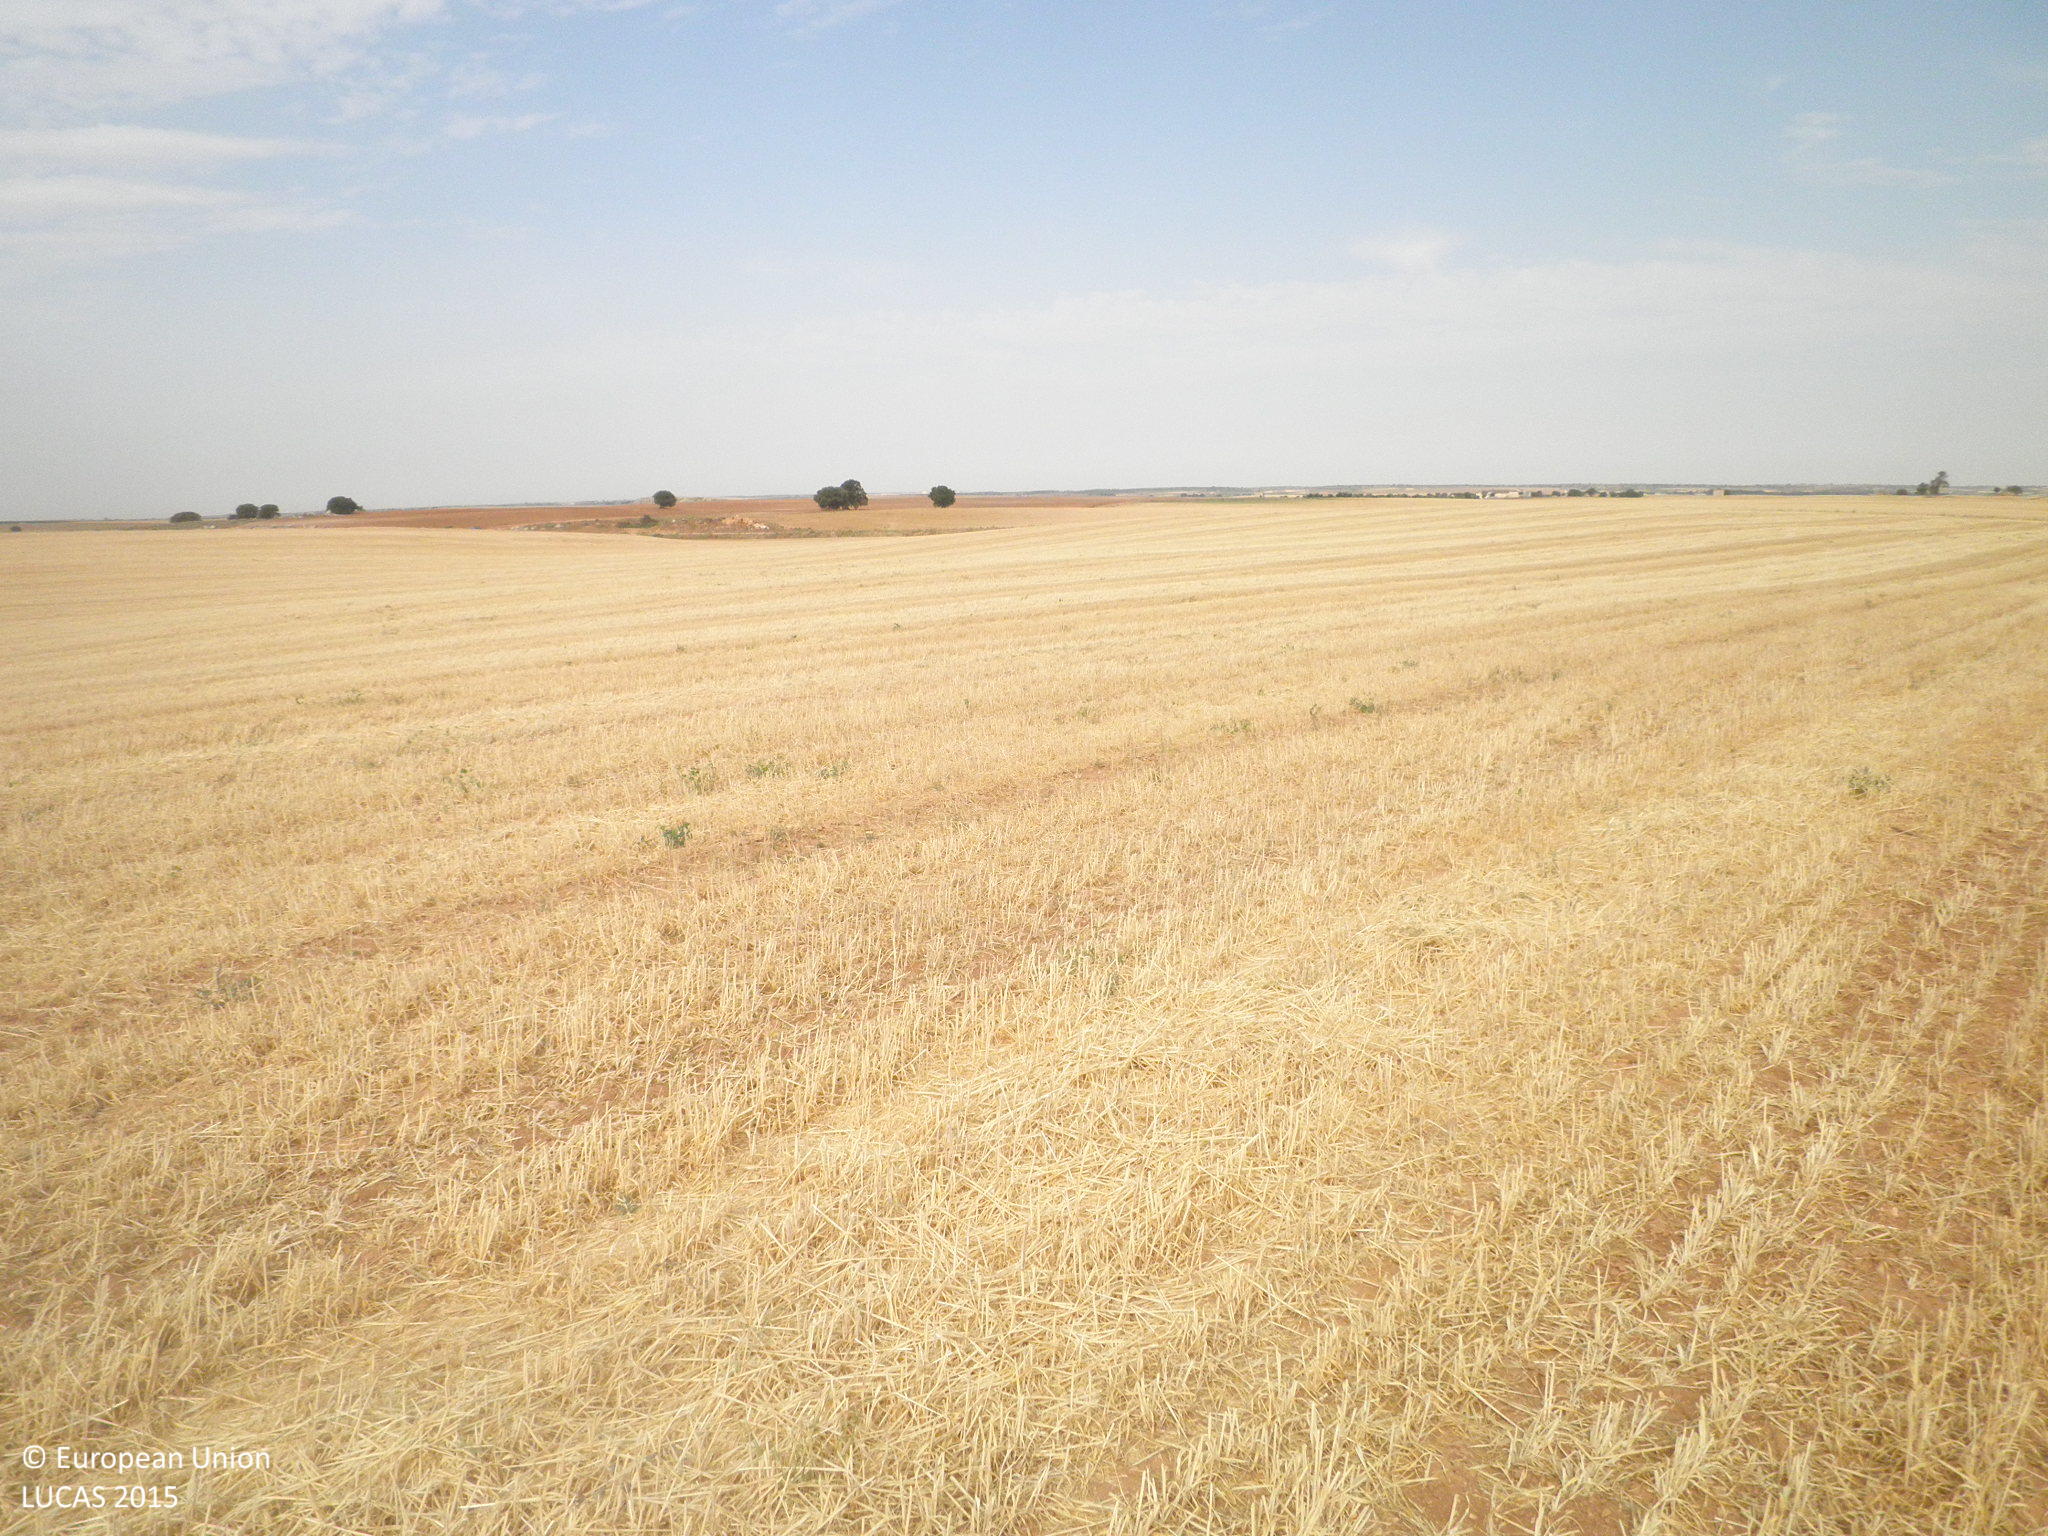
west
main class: Cropland
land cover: Barley
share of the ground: 50 - 75 %
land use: Agriculture (excluding fallow land and kitchen gardens)
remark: Harvested field
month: July
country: ES
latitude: 39.5259
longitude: -2.7298
